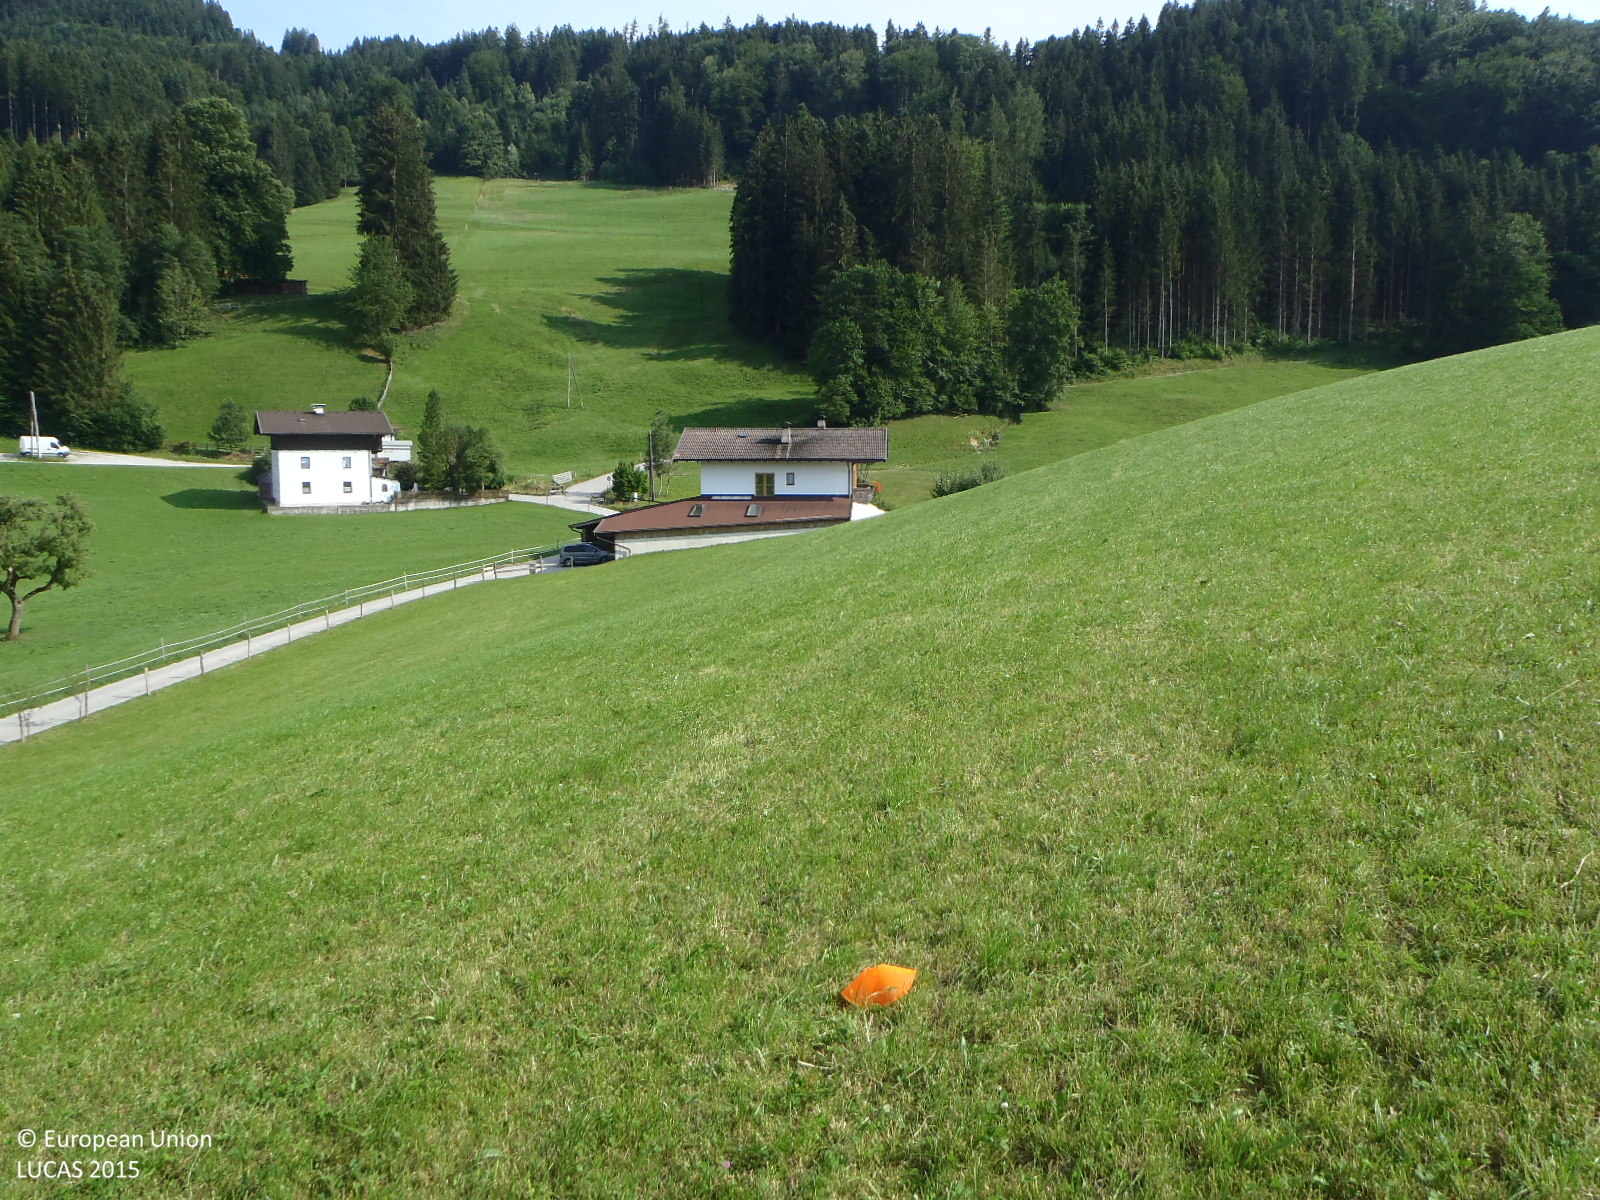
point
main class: Grassland
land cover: Grassland without tree/shrub cover
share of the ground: > 75 %
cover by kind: herbaceous plants 100 %
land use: Agriculture (excluding fallow land and kitchen gardens)
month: July
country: AT
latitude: 47.5012
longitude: 12.1093
